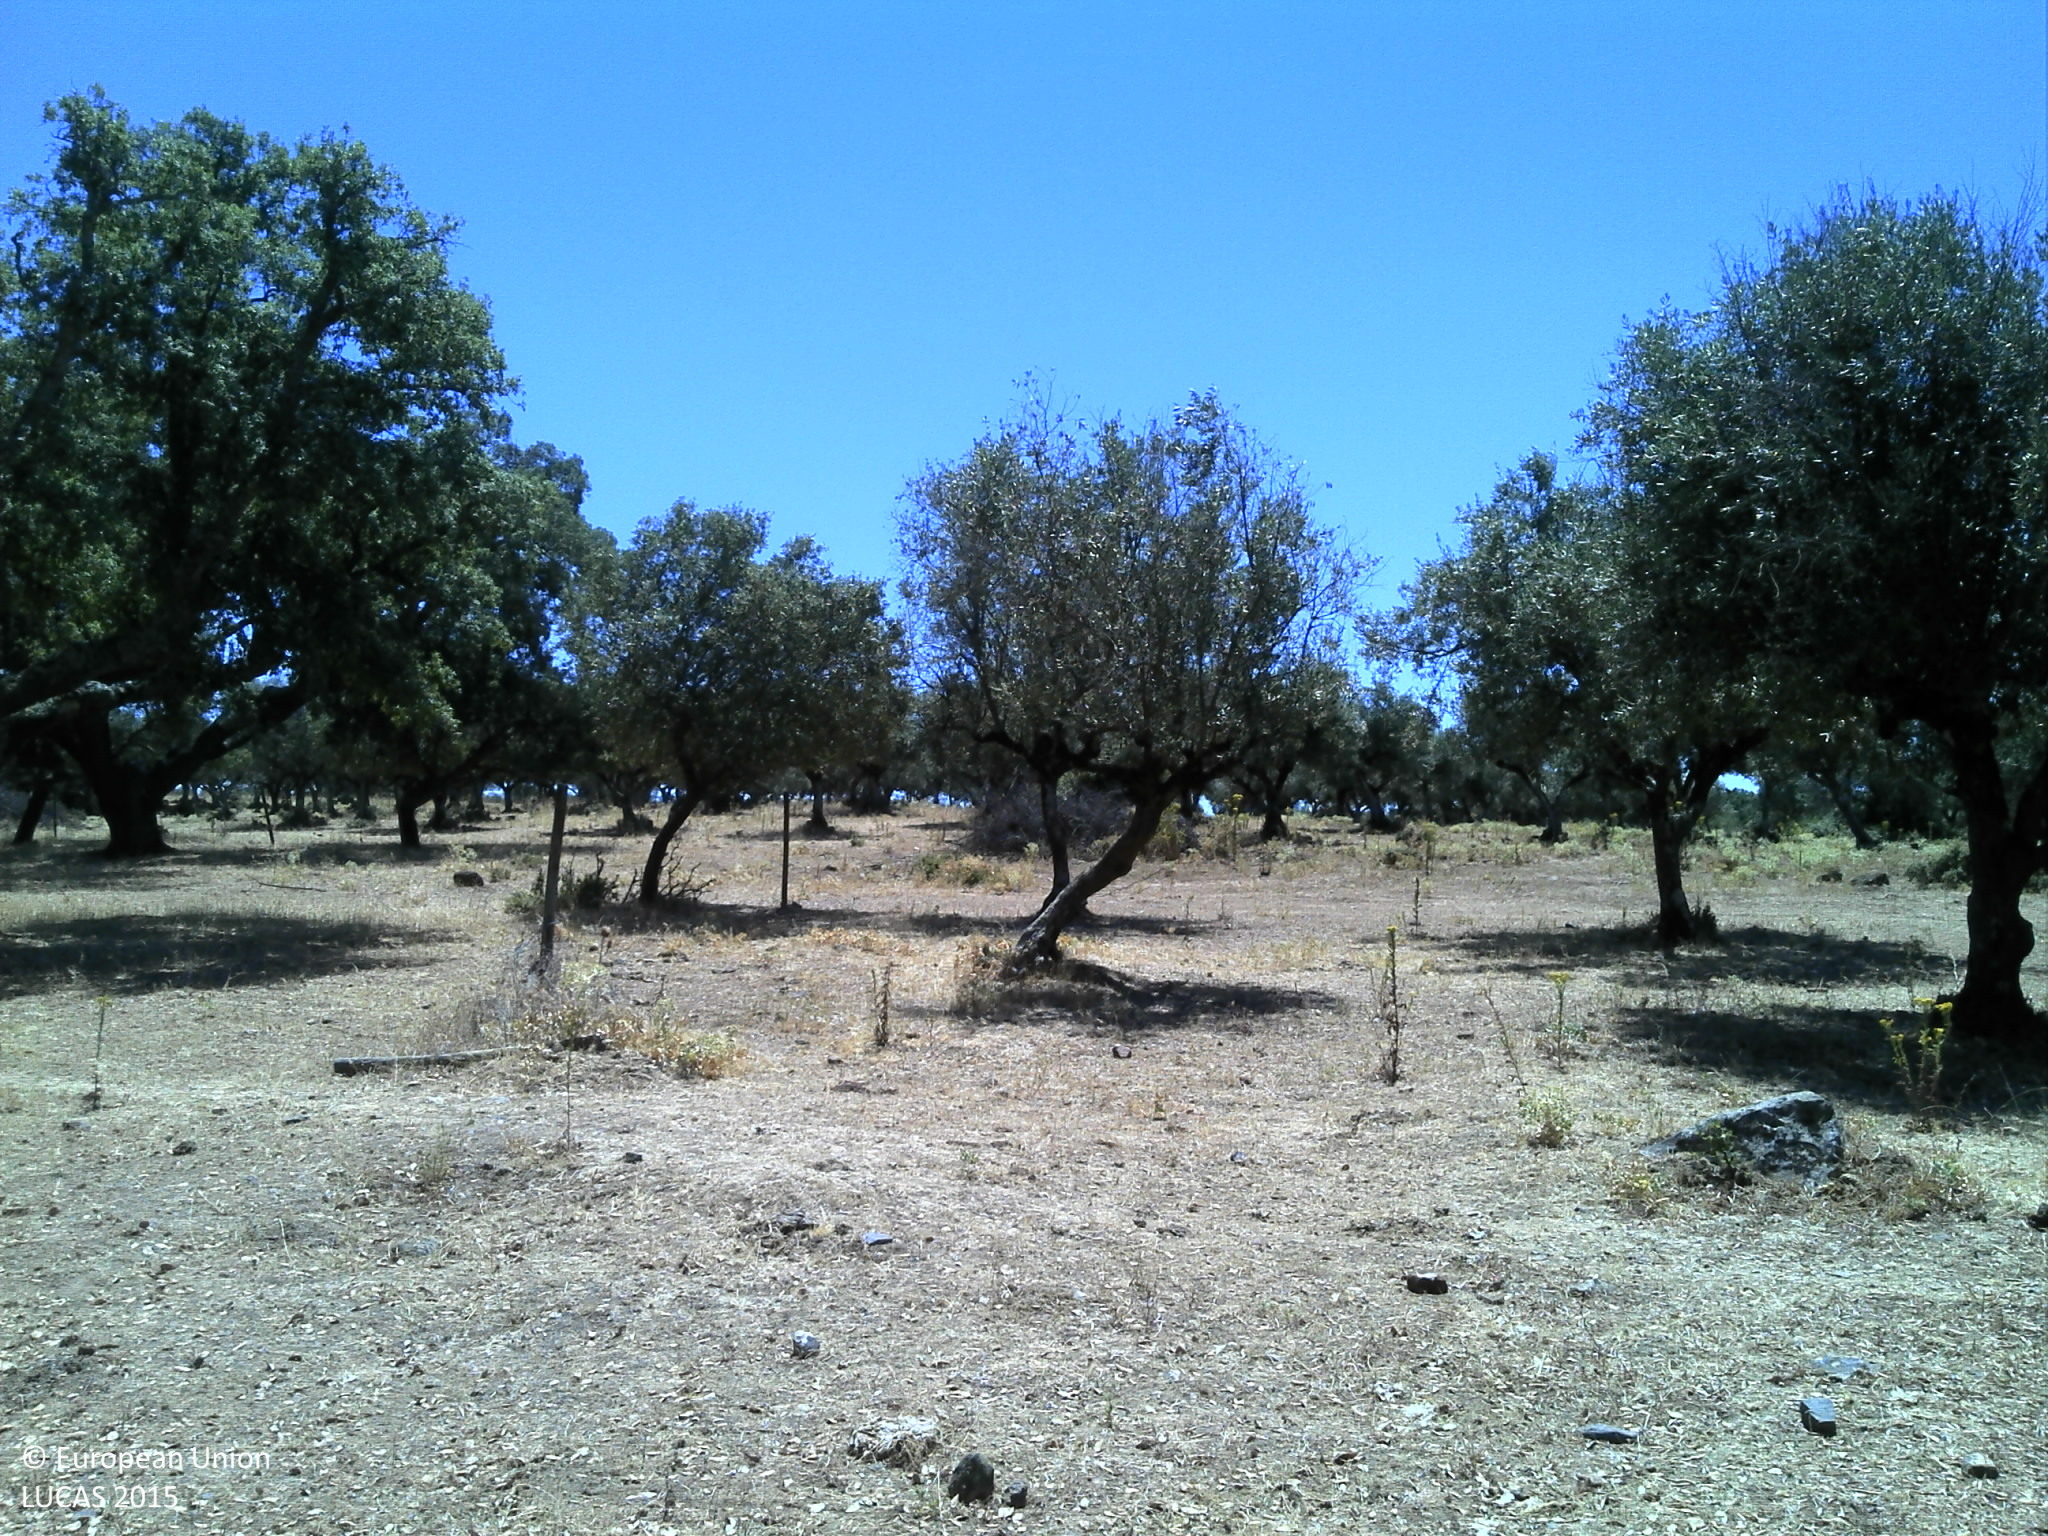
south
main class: Woodland
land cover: Broadleaved woodland
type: broadleaved evergreen forest
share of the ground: 50 - 75 %
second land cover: Grassland without tree/shrub cover
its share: 10 - 25 %
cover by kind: broadleaved forest trees 50 %, unconsolidated bare surface 30 %, herbaceous plants 20 %
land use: Forestry
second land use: Agriculture (excluding fallow land and kitchen gardens)
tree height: > 5 m
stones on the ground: < 10 %
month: July
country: PT
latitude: 38.8578
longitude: -7.5405
